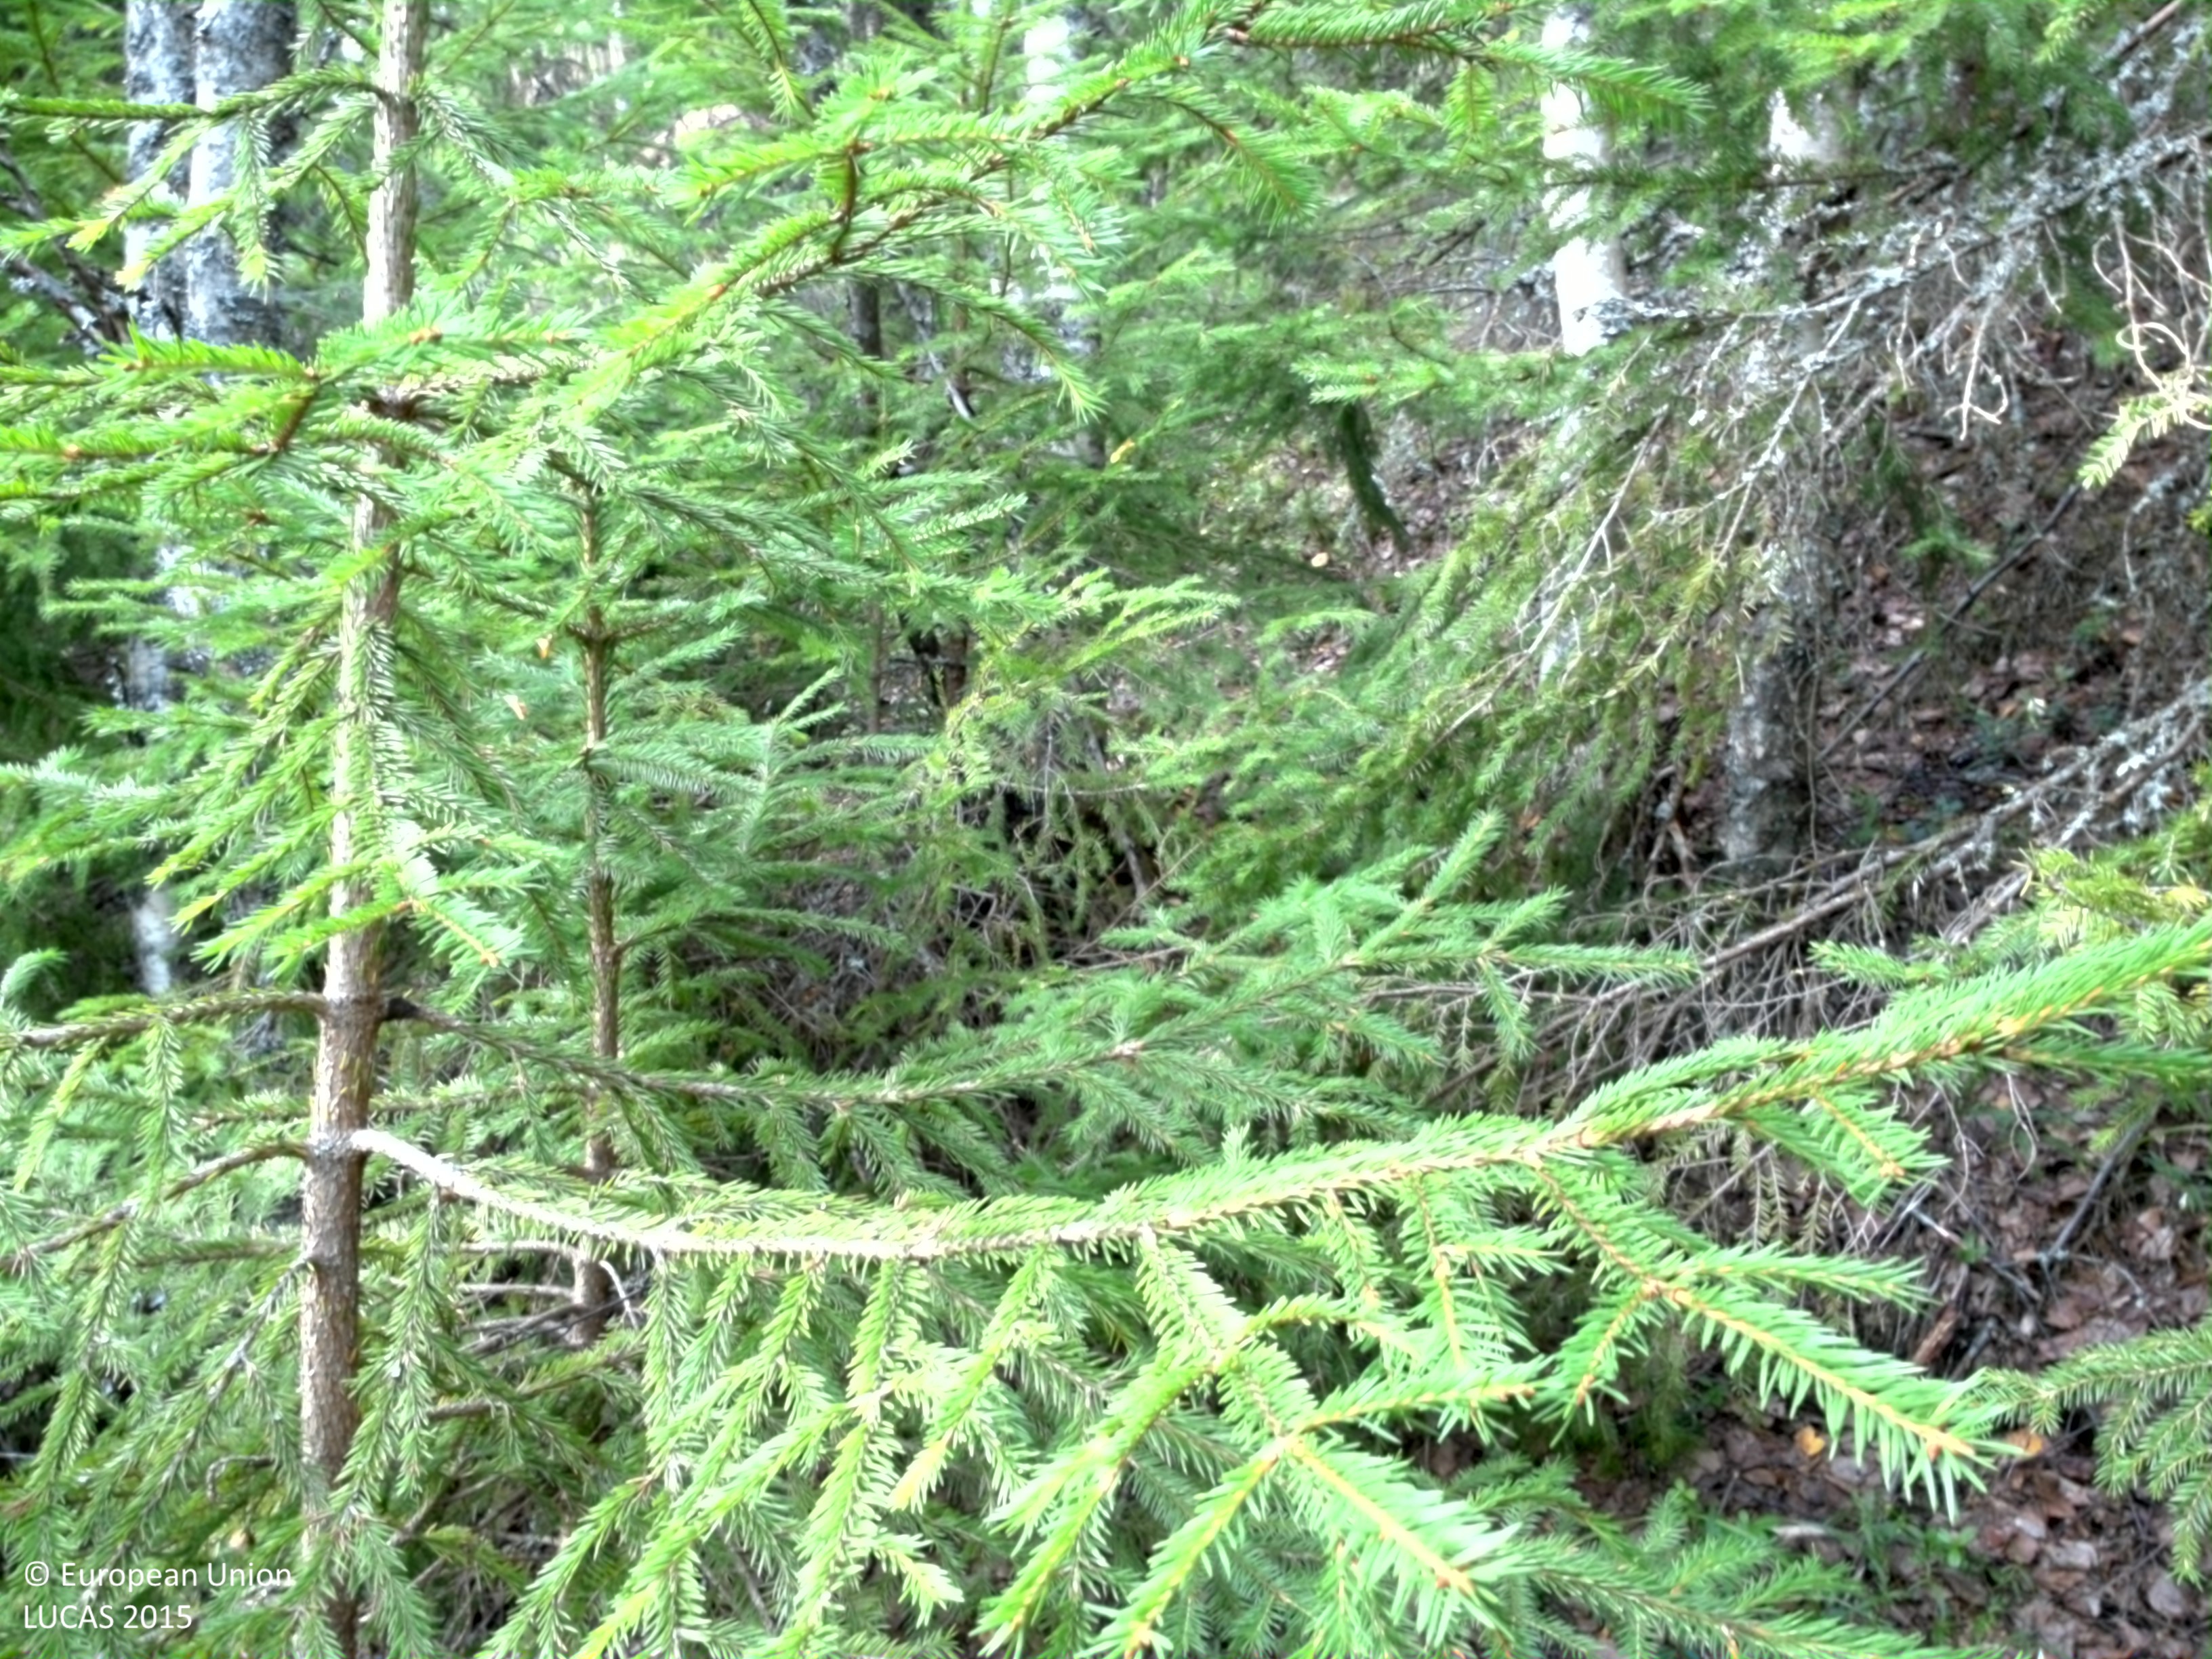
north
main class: Woodland
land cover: Spruce dominated mixed woodland
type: boreal forest
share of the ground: 50 - 75 %
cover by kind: coniferous forest trees 35 %, herbaceous plants 30 %, broadleaved forest trees 15 %, consolidated bare surface 10 %, shrubs 5 %, lichens and mosses 5 %
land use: Forestry
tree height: > 5 m
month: August
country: SE
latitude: 60.0088
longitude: 14.2404
